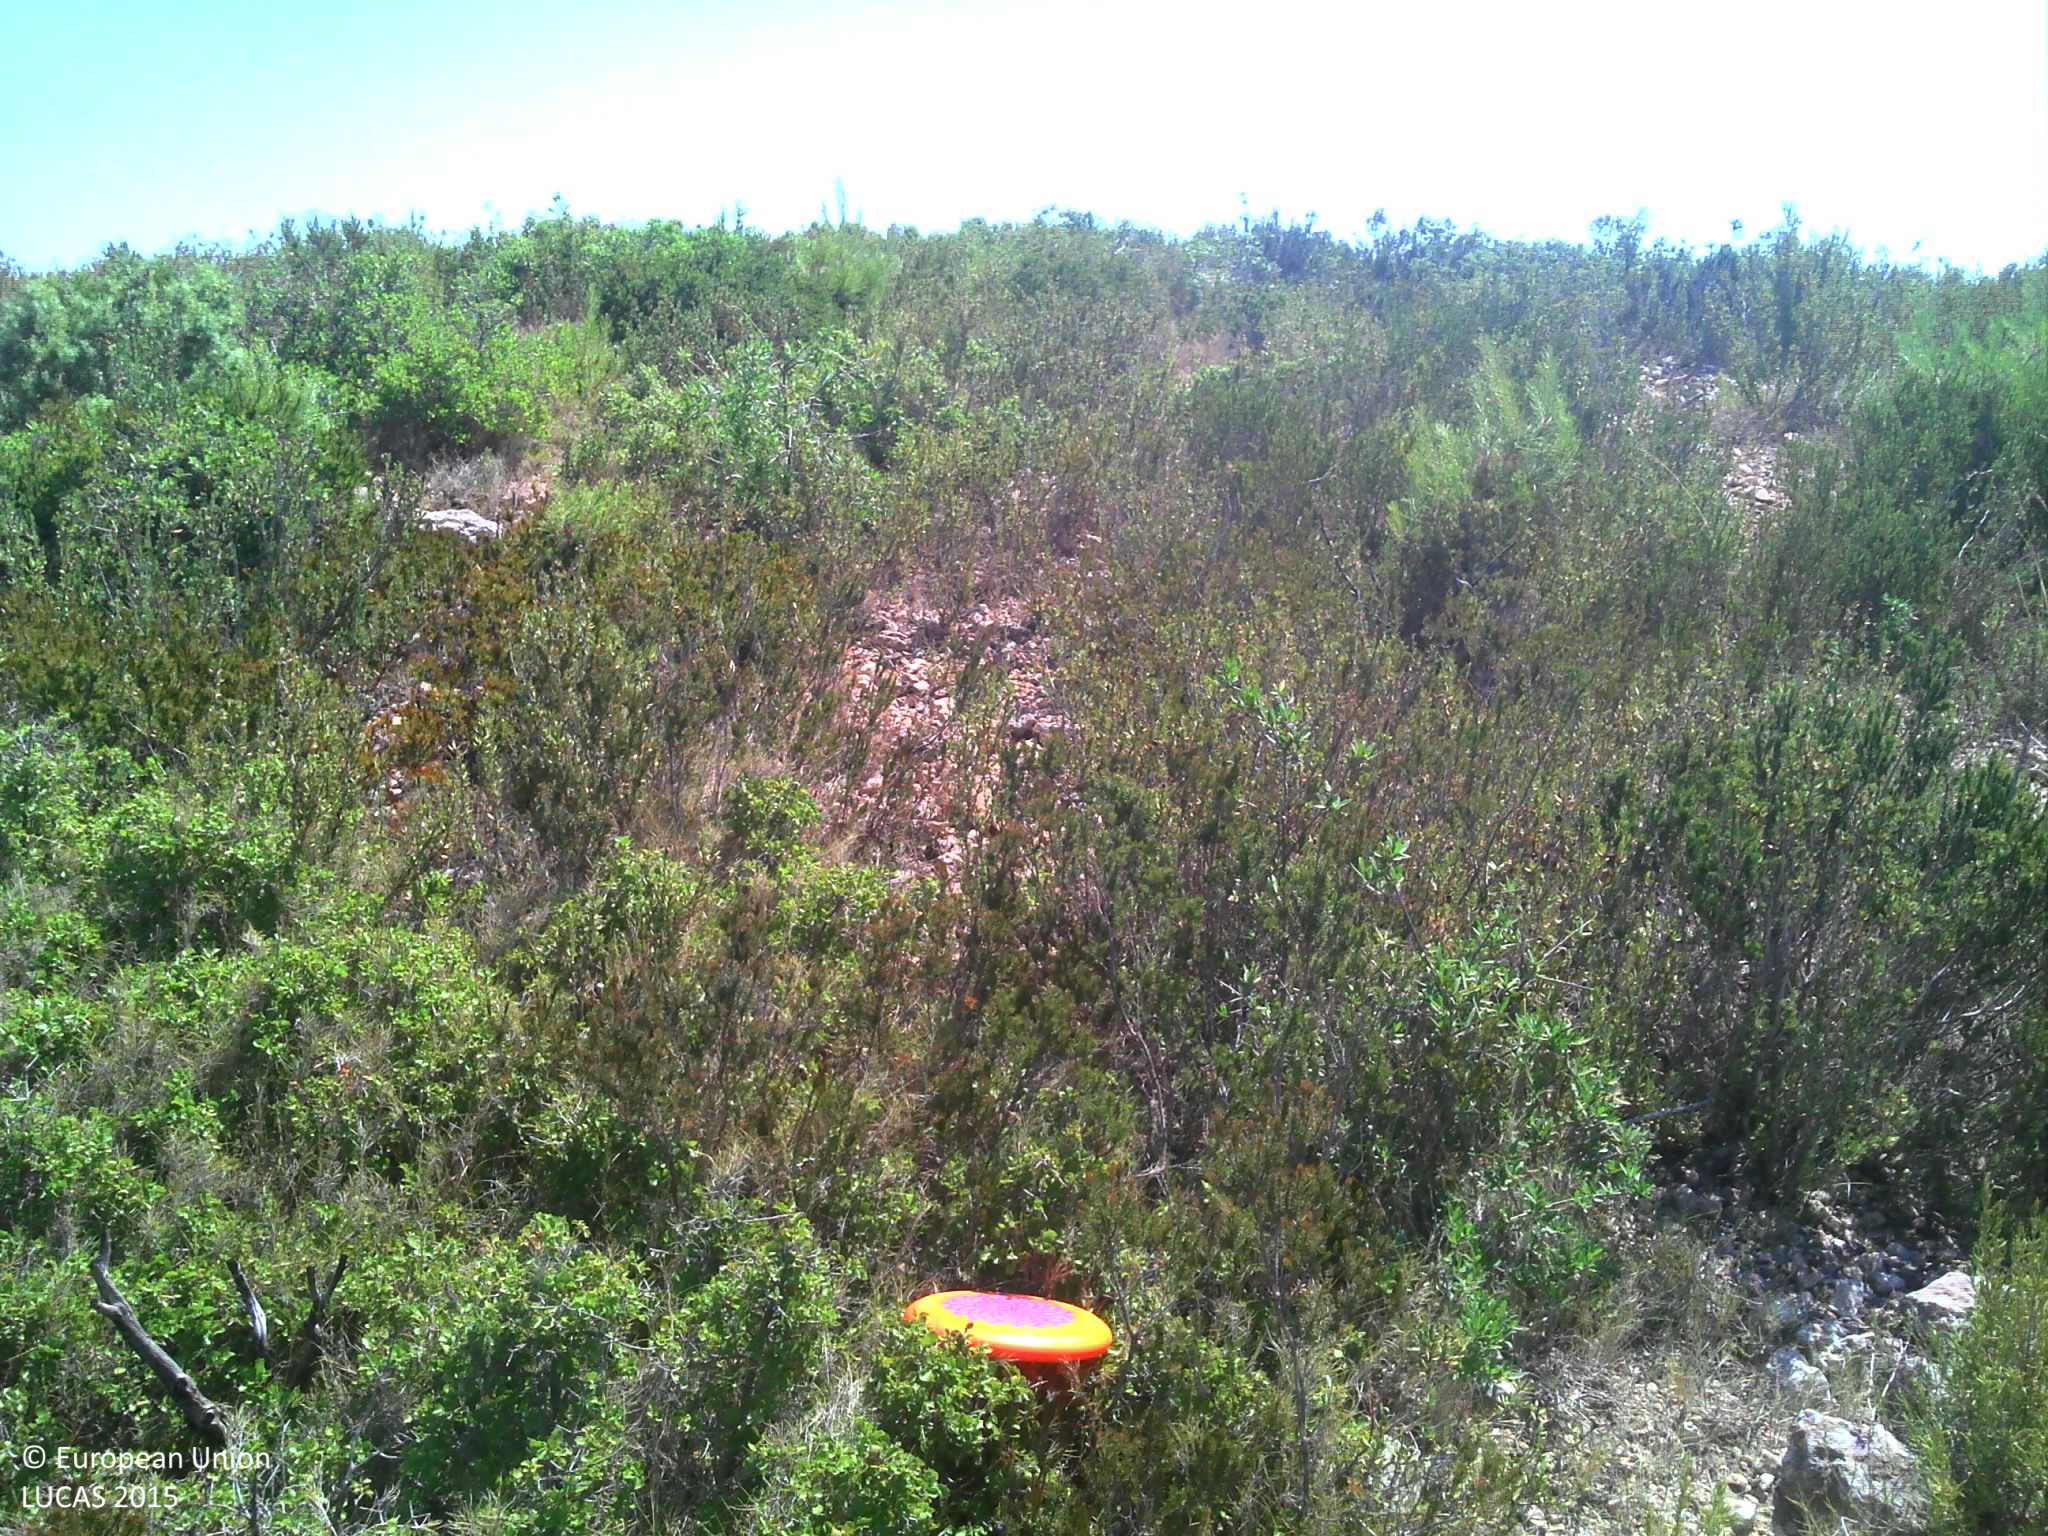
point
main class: Shrubland
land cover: Shrubland without tree cover
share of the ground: > 75 %
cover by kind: shrubs 80 %, unconsolidated bare surface 15 %, consolidated bare surface 5 %
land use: Semi-natural and natural areas not in use
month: August
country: FR
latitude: 43.4660
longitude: 5.2759
